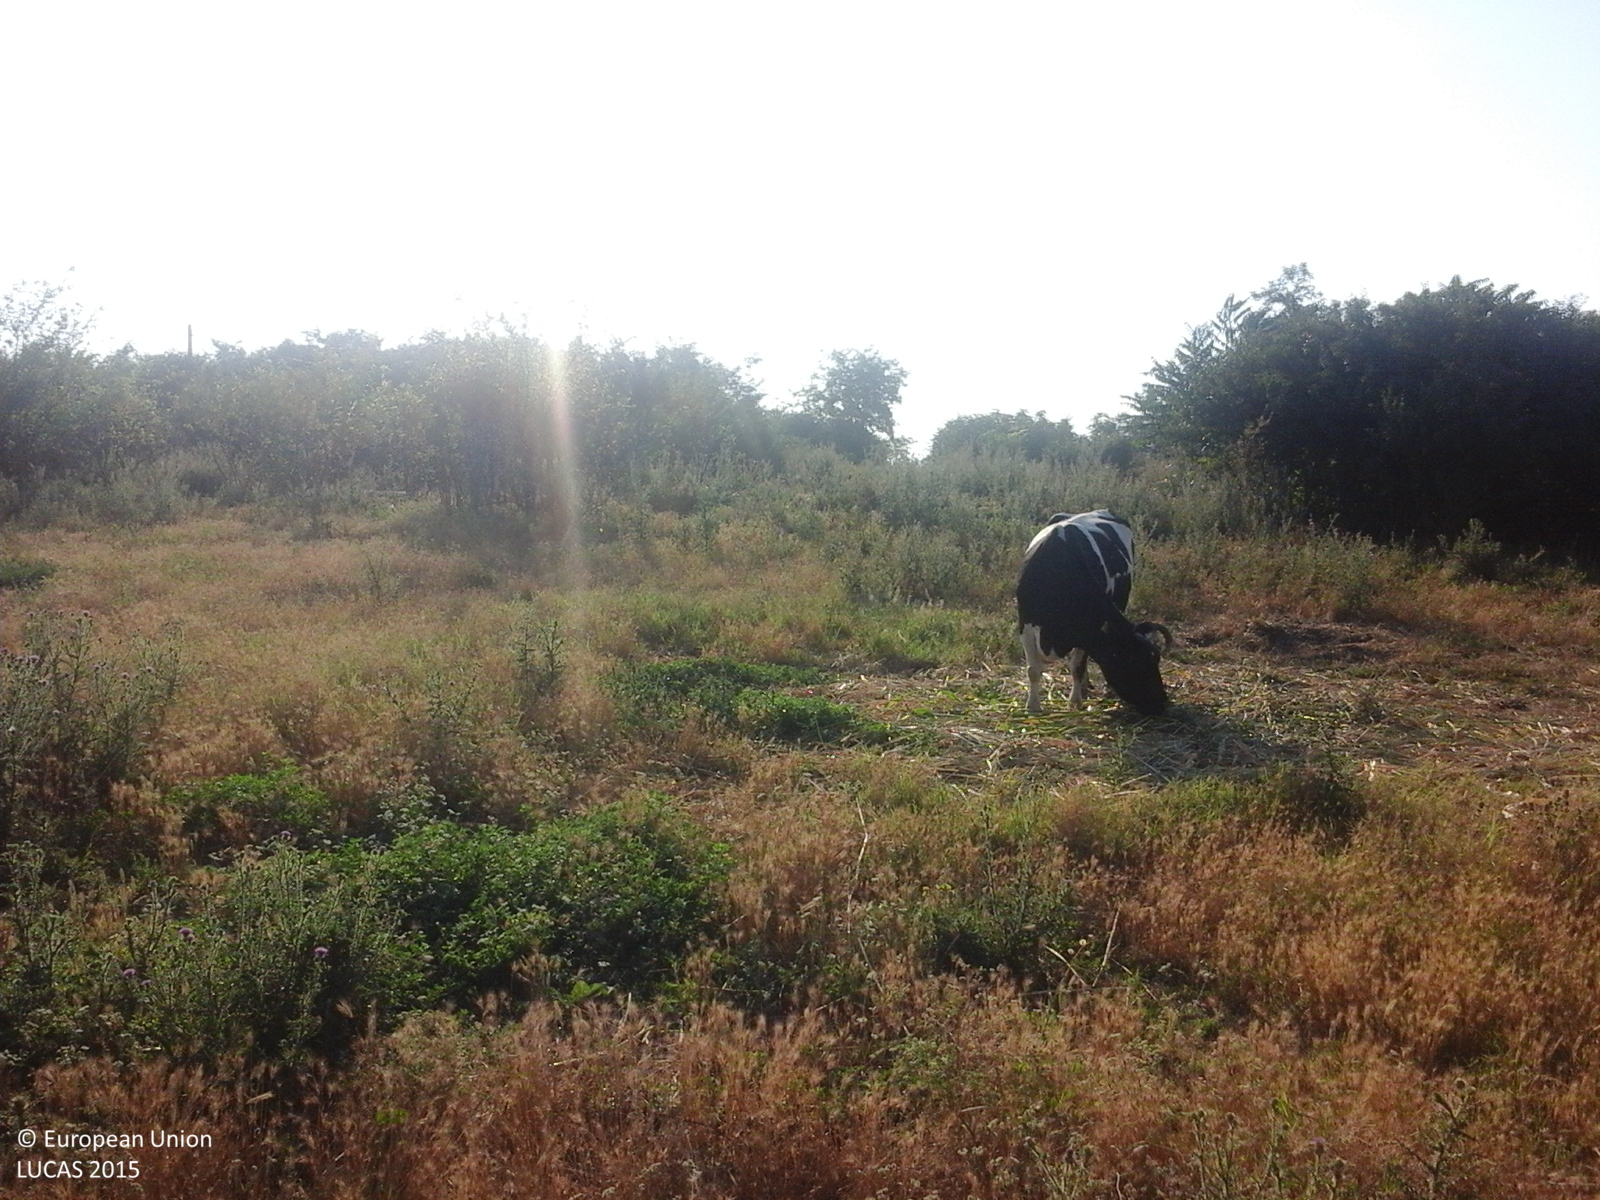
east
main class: Grassland
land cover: Spontaneously vegetated surfaces
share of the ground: > 75 %
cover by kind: herbaceous plants 100 %
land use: Semi-natural and natural areas not in use
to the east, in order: Spontaneously vegetated surfaces; Fences; Vineyards; Tomatoes; Artificial constructions in urban areas; Spontaneously vegetated surfaces; Electric lines; Spontaneously vegetated surfaces; Lines of trees; Tracks; Grass margins; Fences; Other fruit trees and berries; Lines of trees; Common wheat; Electric lines; Common wheat; Other leguminous and mixtures for fodder
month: July
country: RO
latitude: 44.4085
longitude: 26.9922
